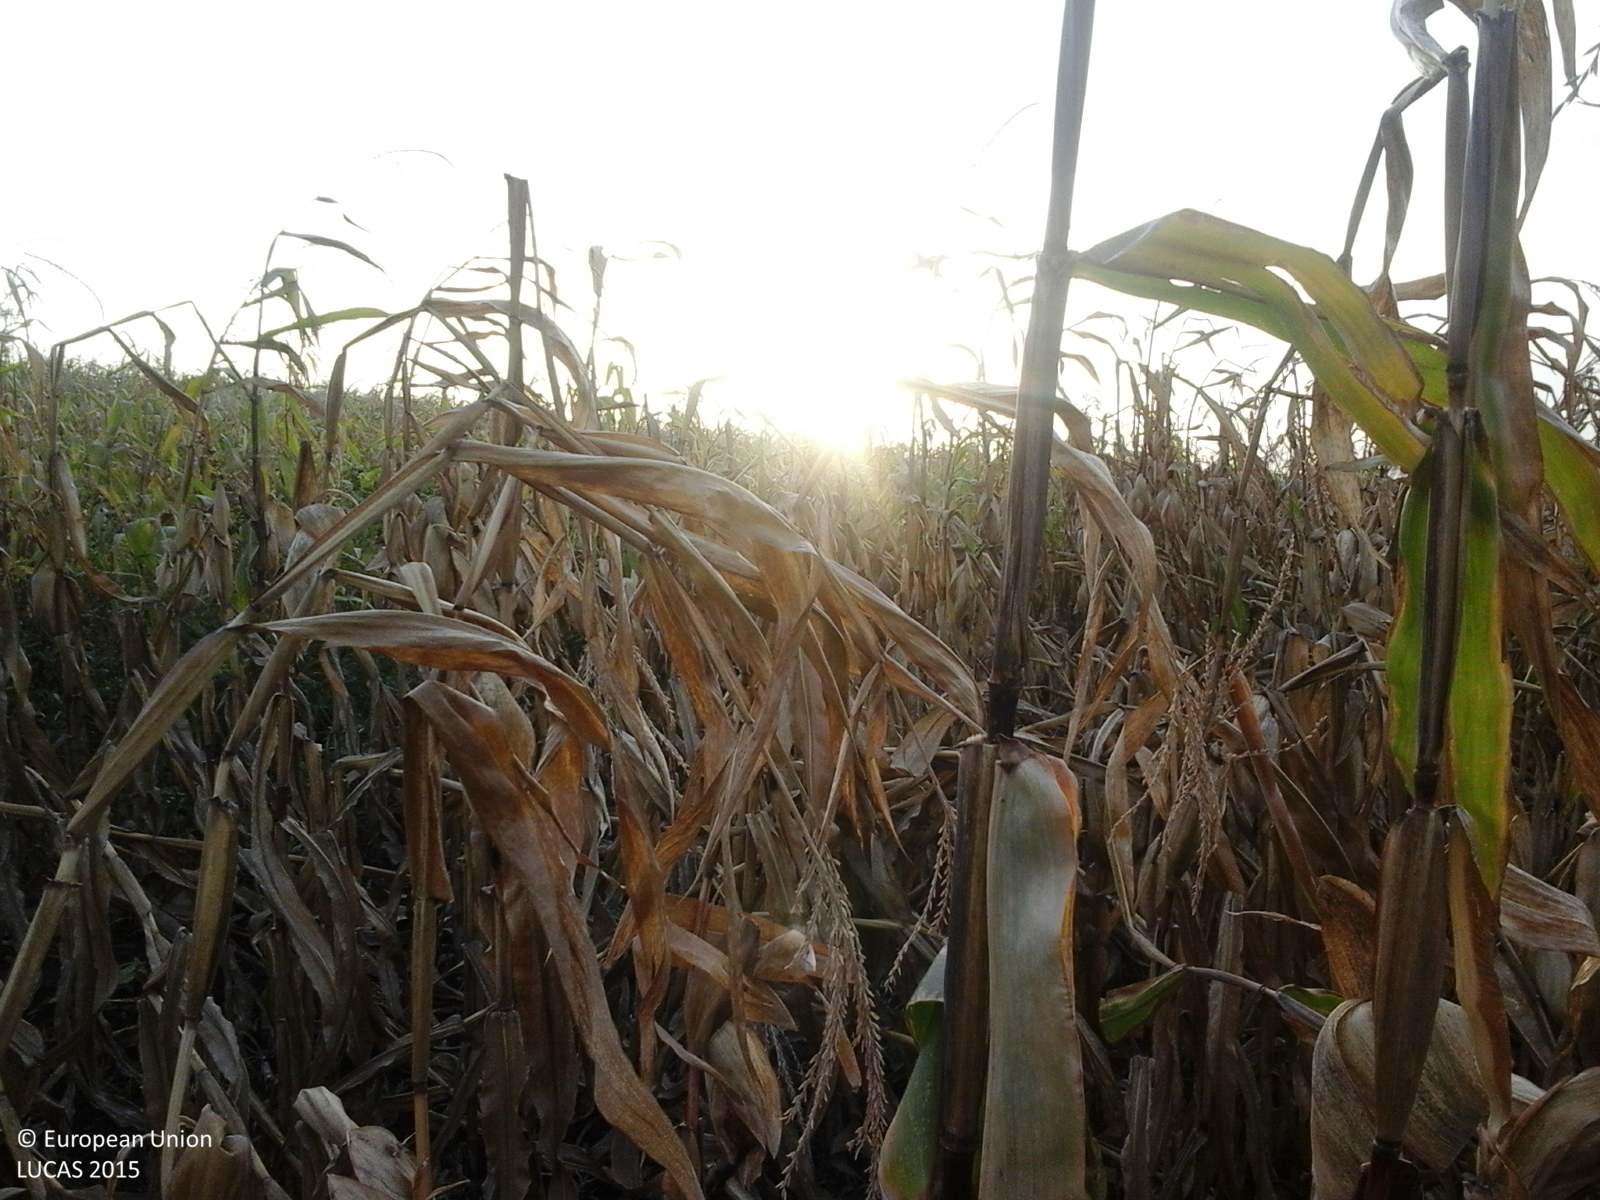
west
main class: Cropland
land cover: Maize
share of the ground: > 75 %
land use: Agriculture (excluding fallow land and kitchen gardens)
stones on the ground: < 10 %
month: September
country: RO
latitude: 46.5439
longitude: 23.9649
